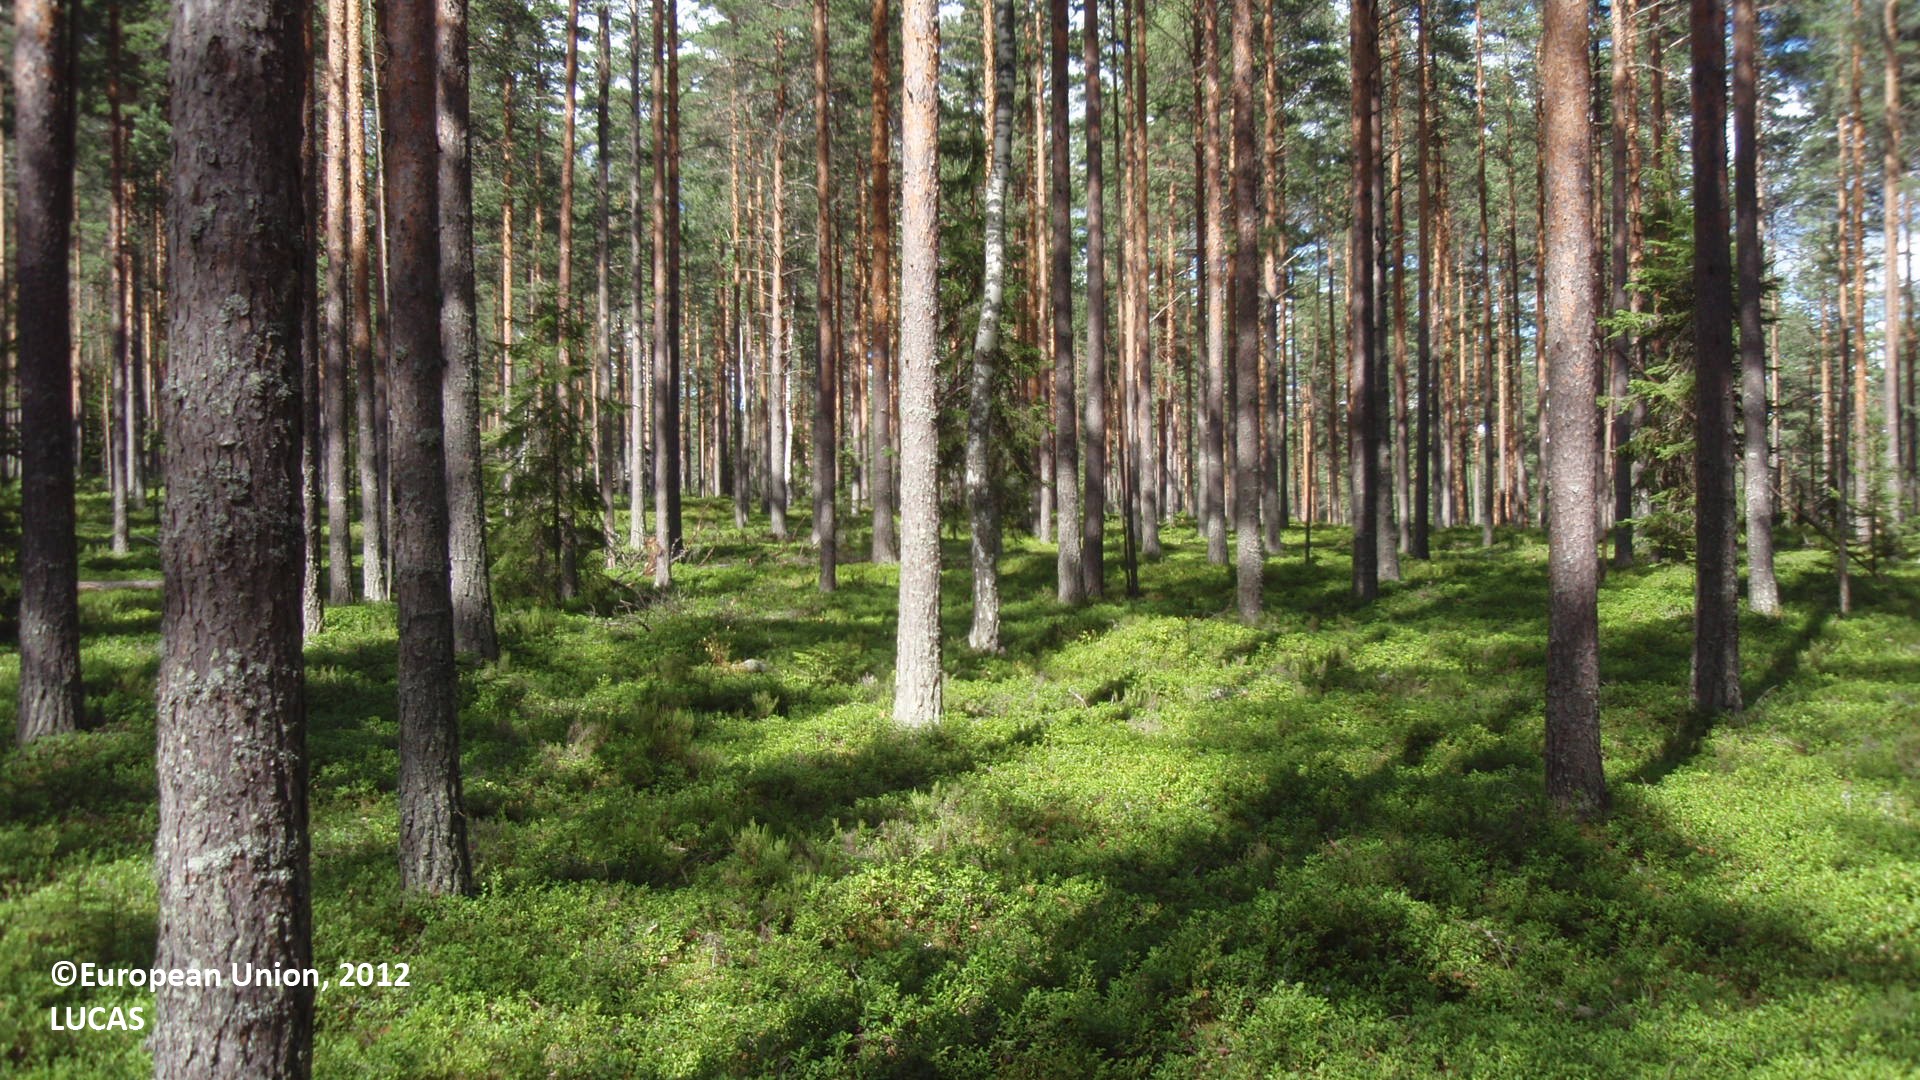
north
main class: Woodland
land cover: Pine dominated coniferous woodland
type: boreal forest
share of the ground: 25 - 50 %
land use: Forestry
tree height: > 5 m
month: July
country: FI
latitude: 61.6618
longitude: 27.8447
